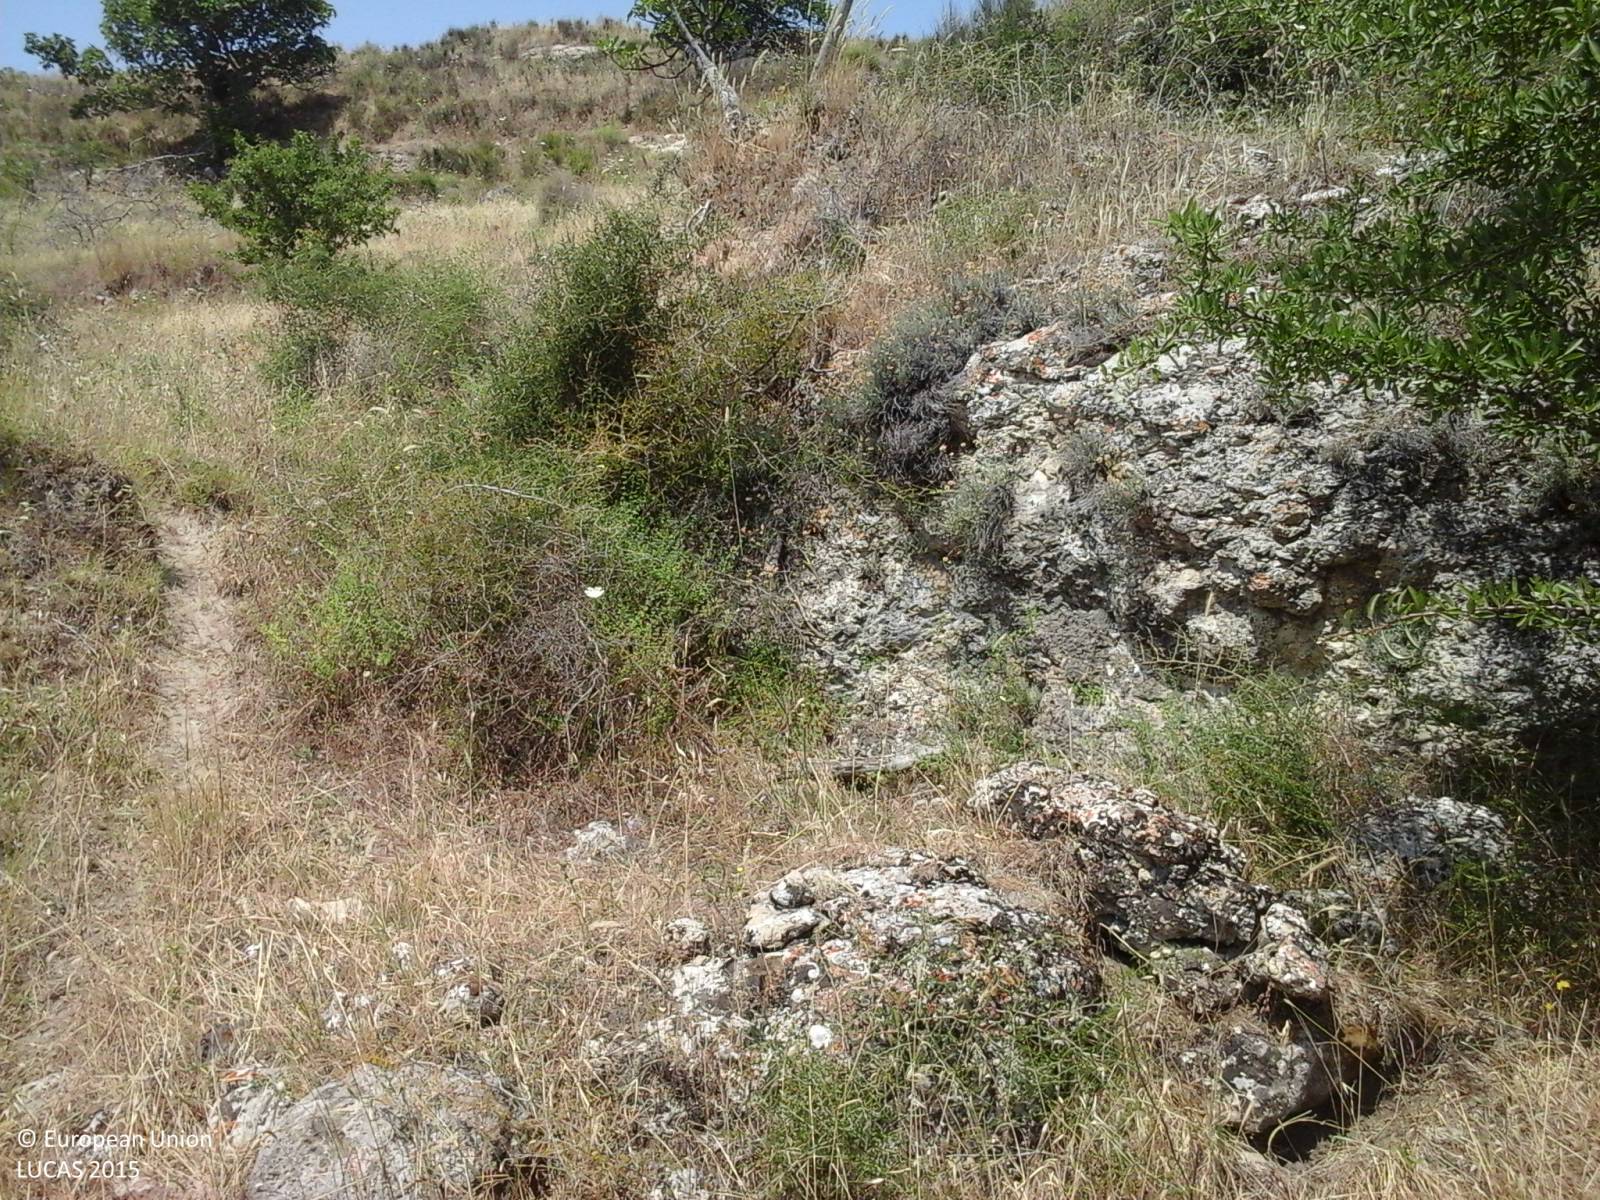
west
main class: Grassland
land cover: Grassland without tree/shrub cover
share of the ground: 25 - 50 %
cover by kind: herbaceous plants 100 %
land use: Agriculture (excluding fallow land and kitchen gardens)
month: July
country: IT
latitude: 40.4231
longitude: 8.8156
